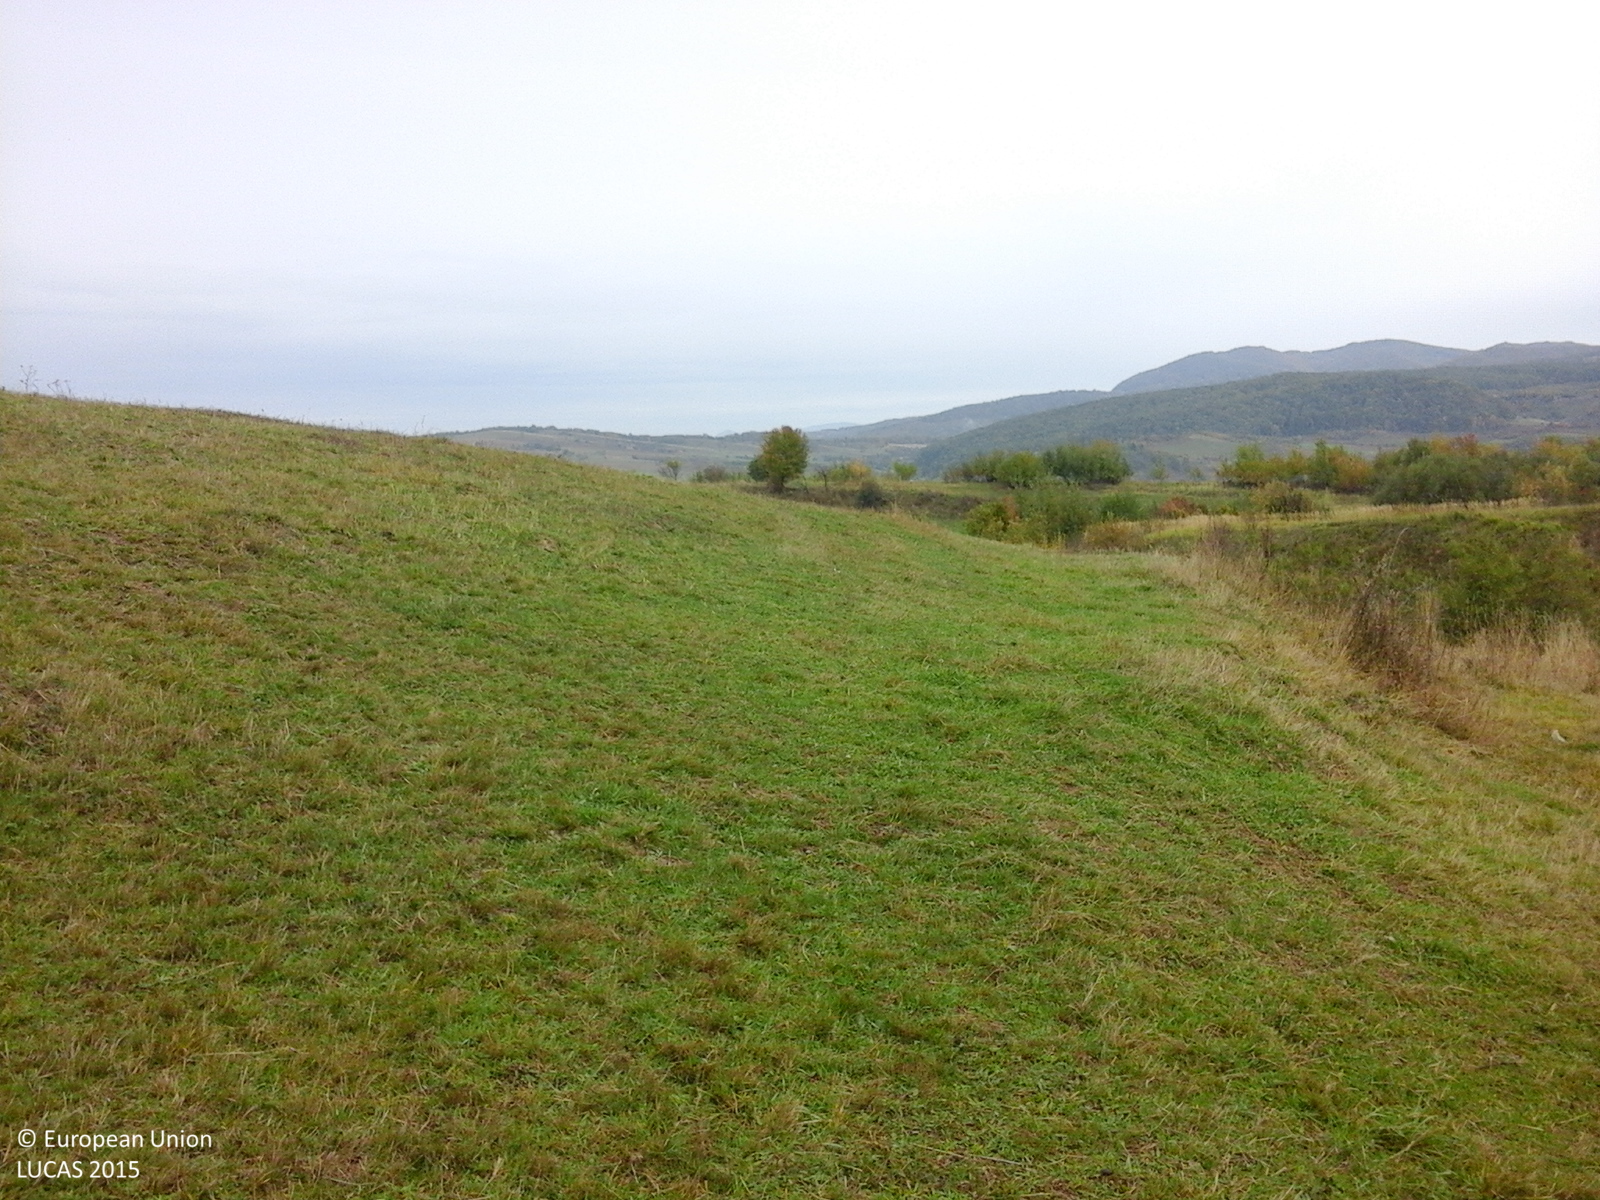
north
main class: Grassland
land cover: Grassland without tree/shrub cover
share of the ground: > 75 %
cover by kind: herbaceous plants 100 %
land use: Agriculture (excluding fallow land and kitchen gardens)
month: October
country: RO
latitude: 46.6508
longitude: 24.9273
